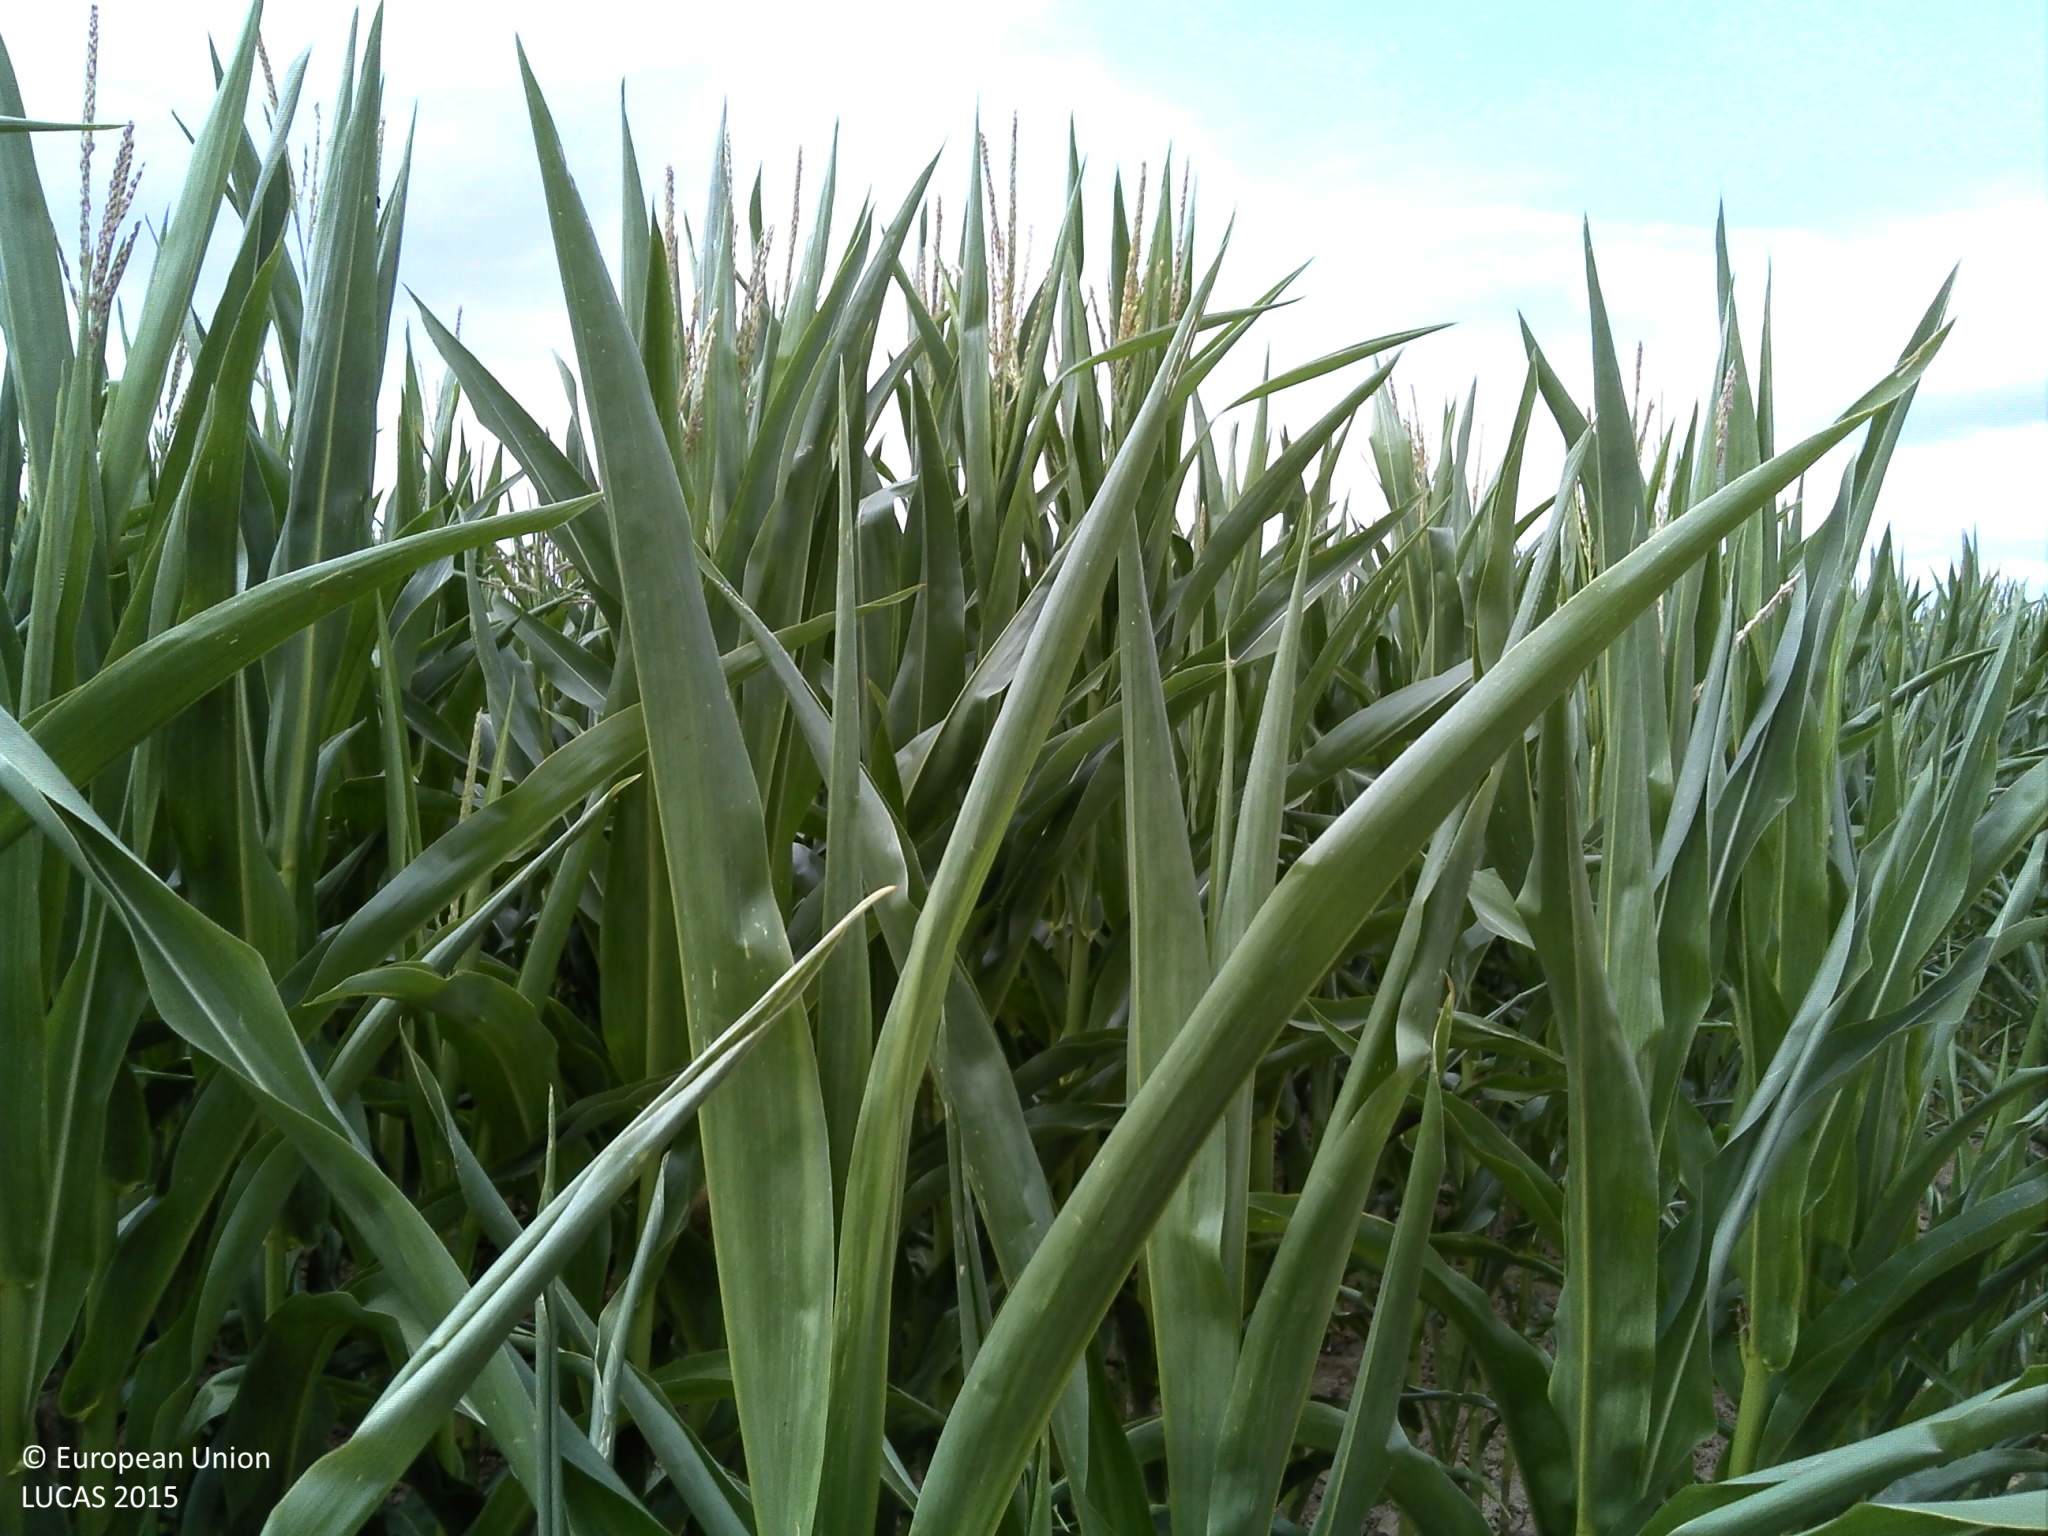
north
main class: Cropland
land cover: Rape and turnip rape
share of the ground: > 75 %
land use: Agriculture (excluding fallow land and kitchen gardens)
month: July
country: FR
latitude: 48.9889
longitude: 4.9003
